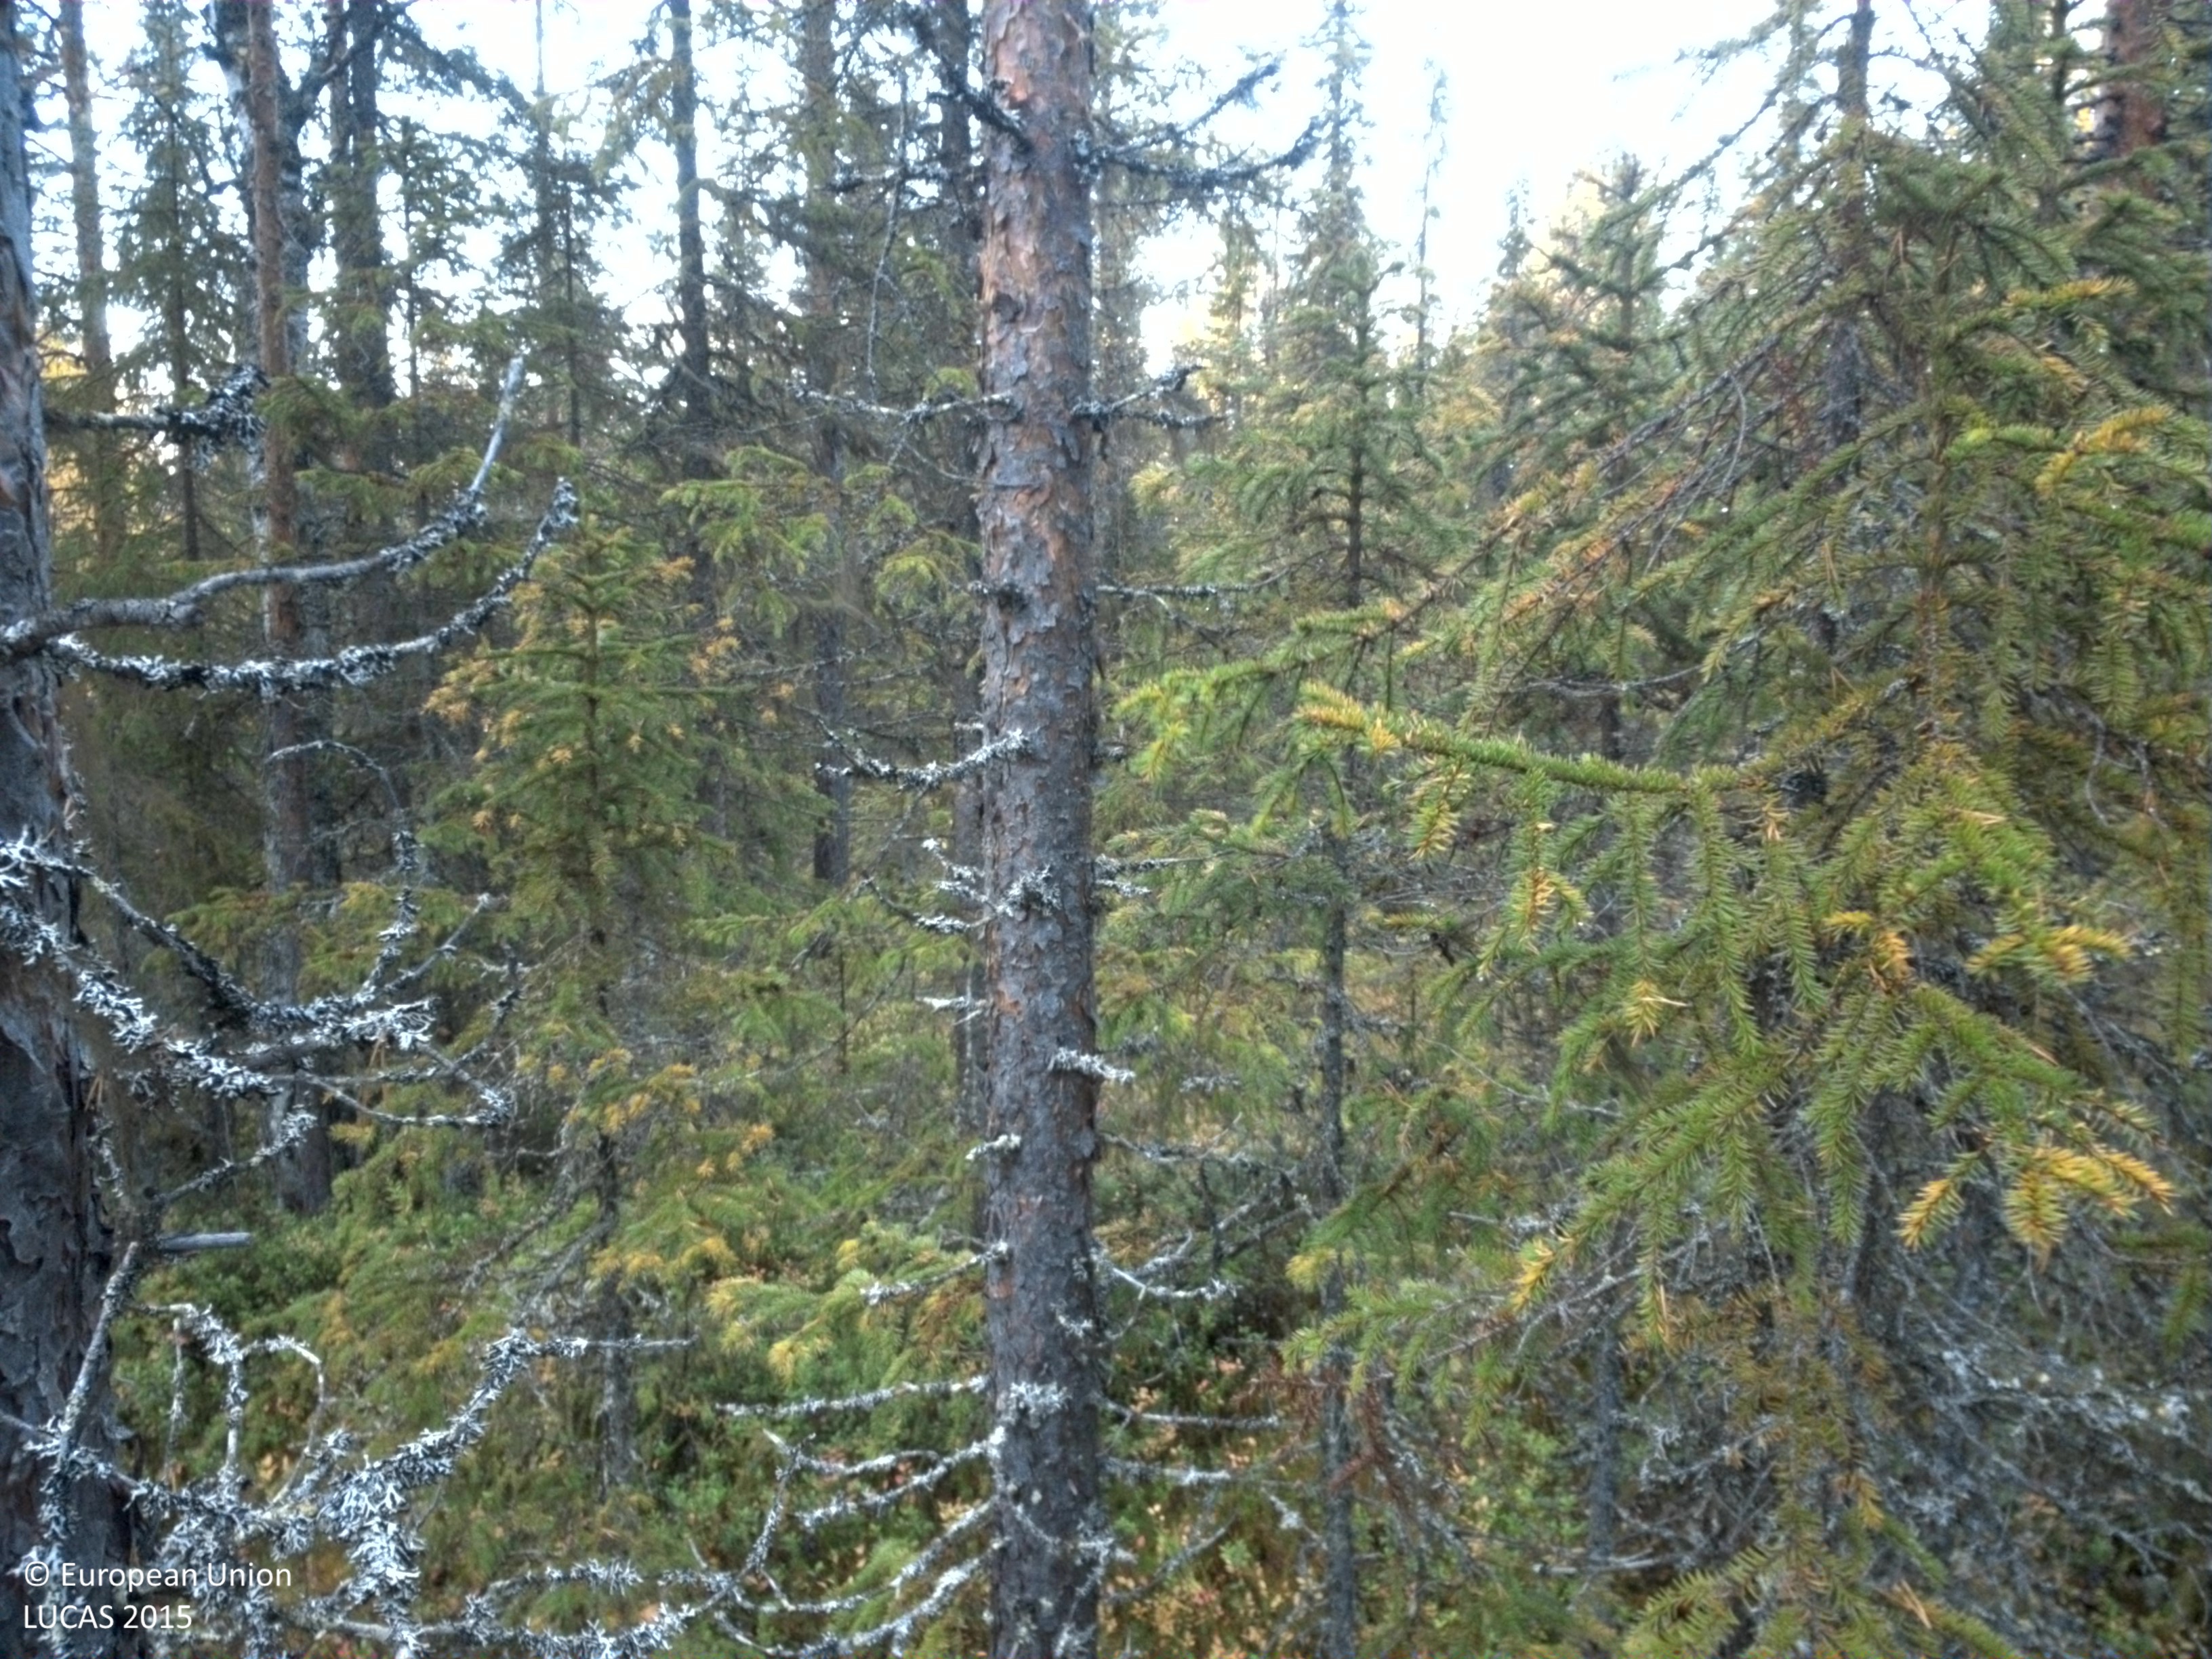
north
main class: Woodland
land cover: Other coniferous woodland
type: boreal forest
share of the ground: 25 - 50 %
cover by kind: coniferous forest trees 45 %, herbaceous plants 35 %, lichens and mosses 20 %
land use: Forestry
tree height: > 5 m
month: September
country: SE
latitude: 65.0876
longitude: 17.6011
